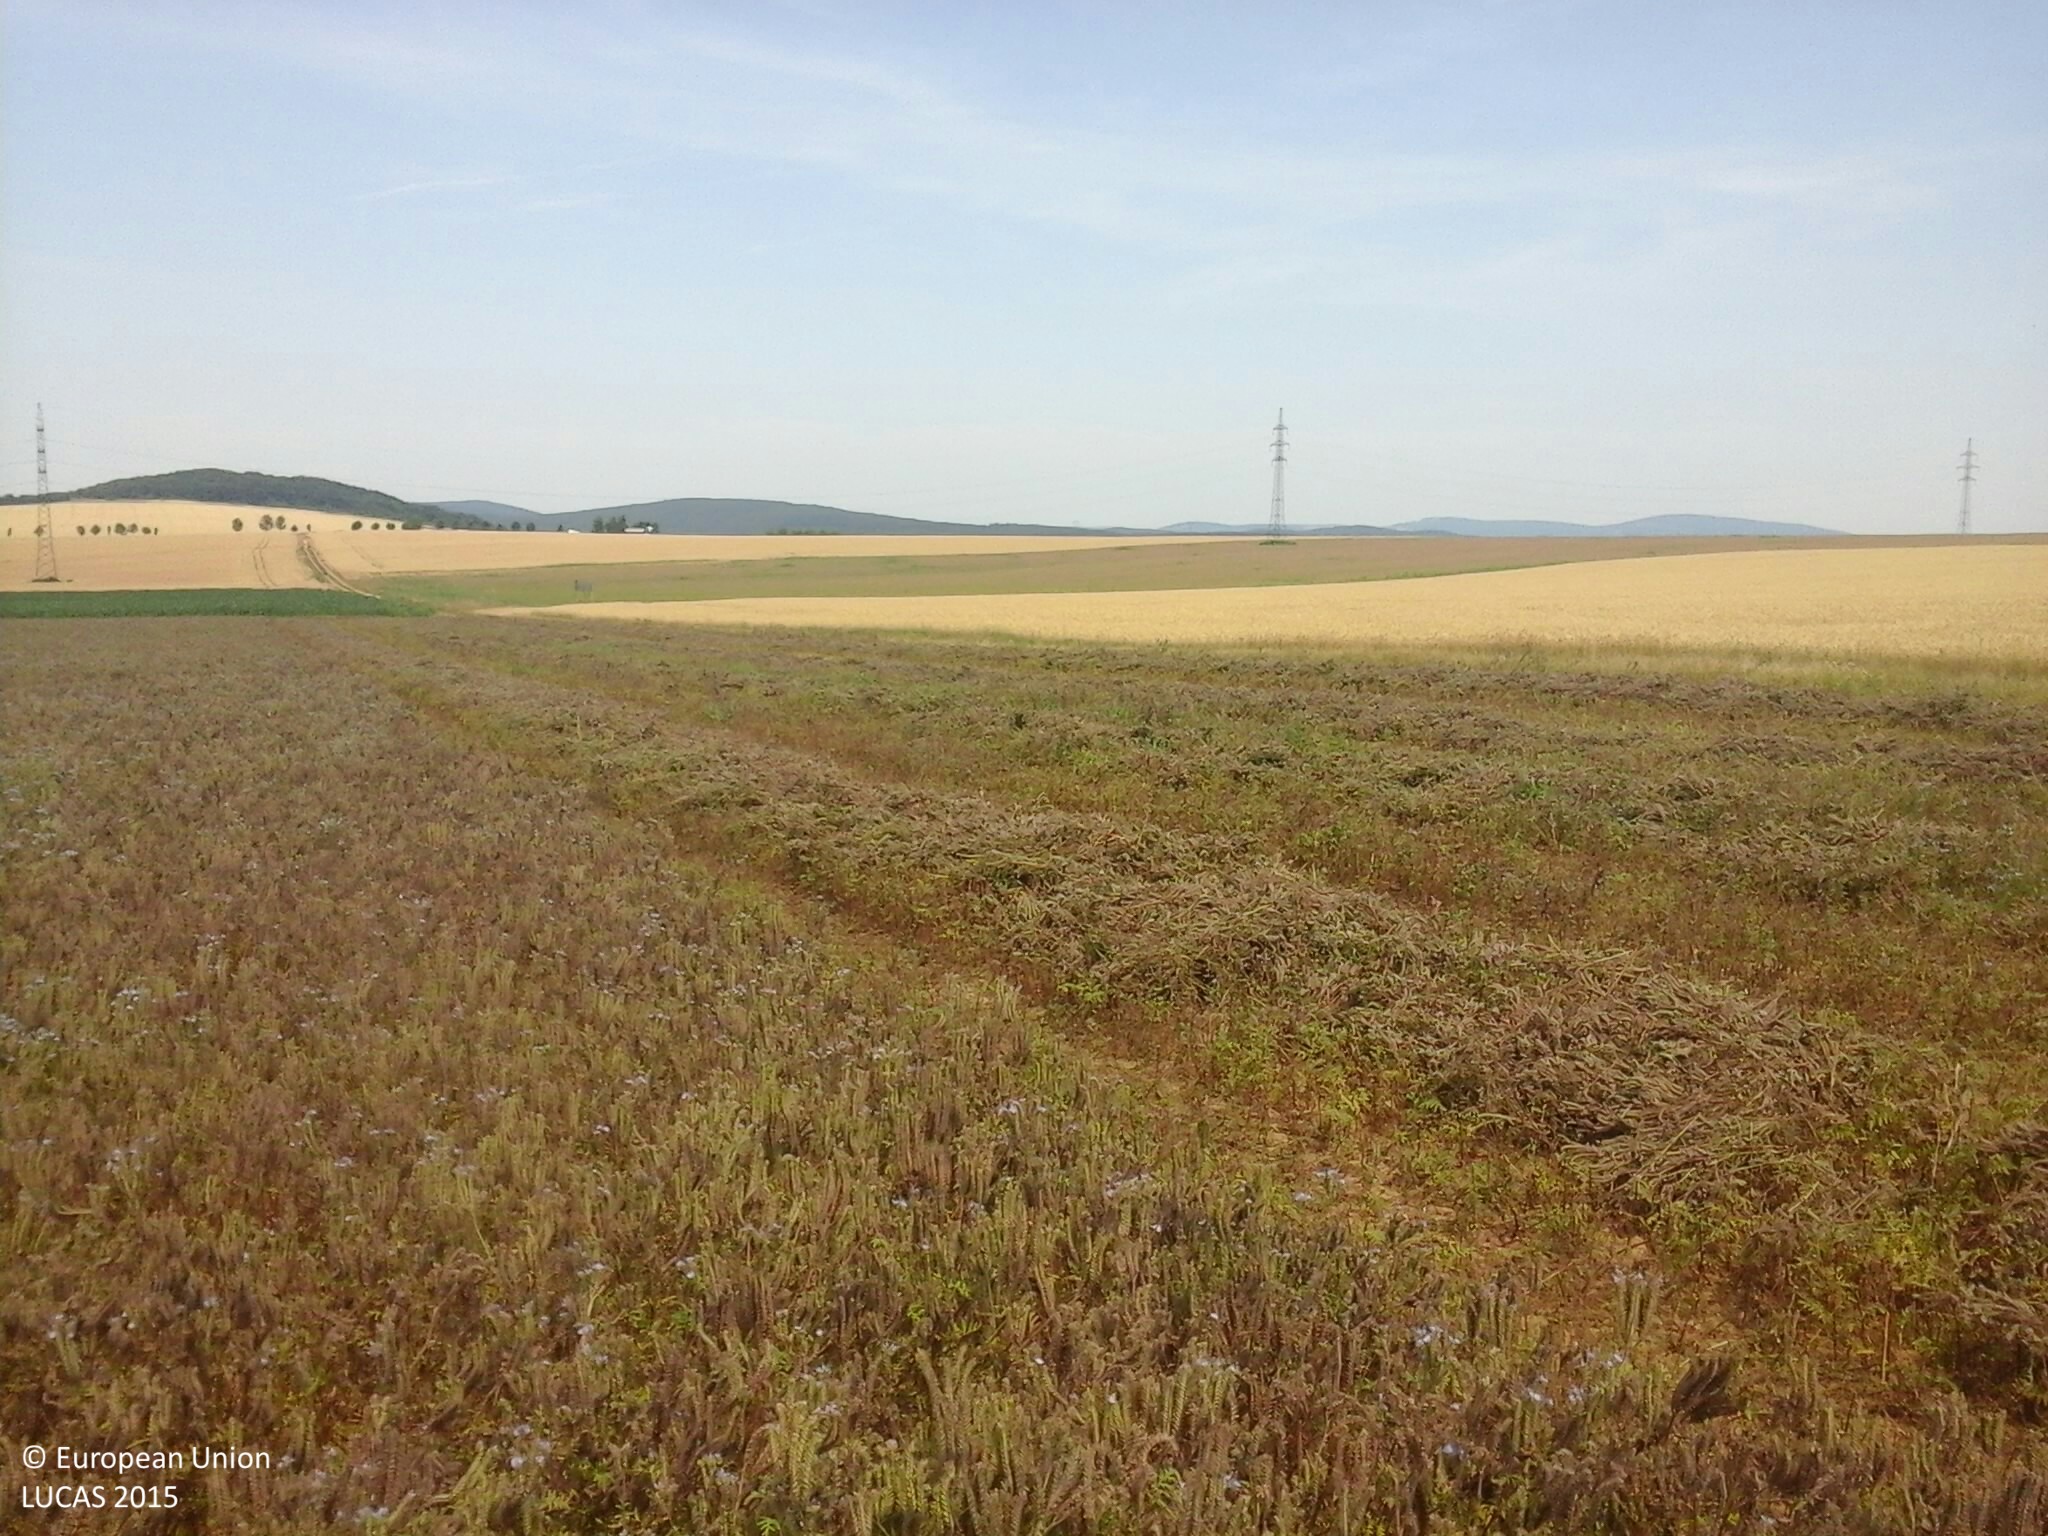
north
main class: Cropland
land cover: Other leguminous and mixtures for fodder
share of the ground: > 75 %
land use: Agriculture (excluding fallow land and kitchen gardens)
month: July
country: HU
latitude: 47.0401
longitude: 17.8392
